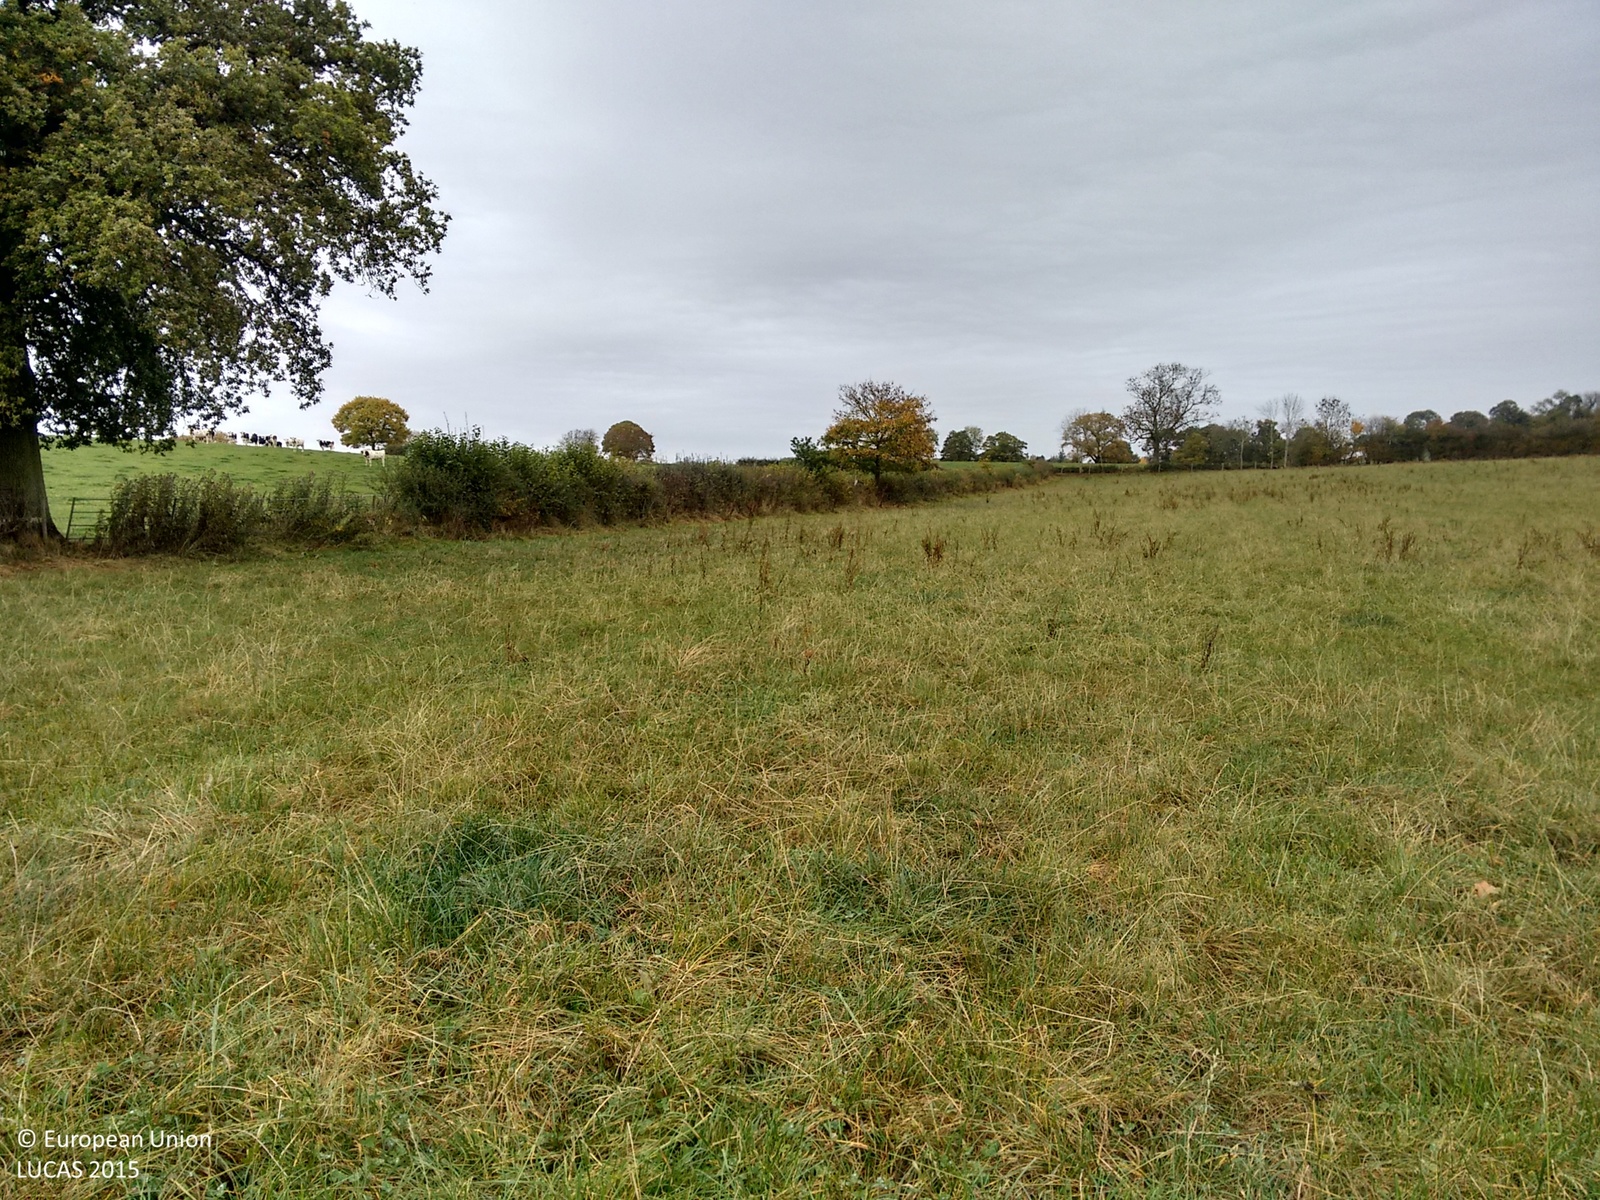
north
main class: Grassland
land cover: Grassland without tree/shrub cover
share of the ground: > 75 %
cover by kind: herbaceous plants 100 %
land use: Agriculture (excluding fallow land and kitchen gardens)
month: October
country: GB
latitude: 52.3505
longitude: -2.5011
